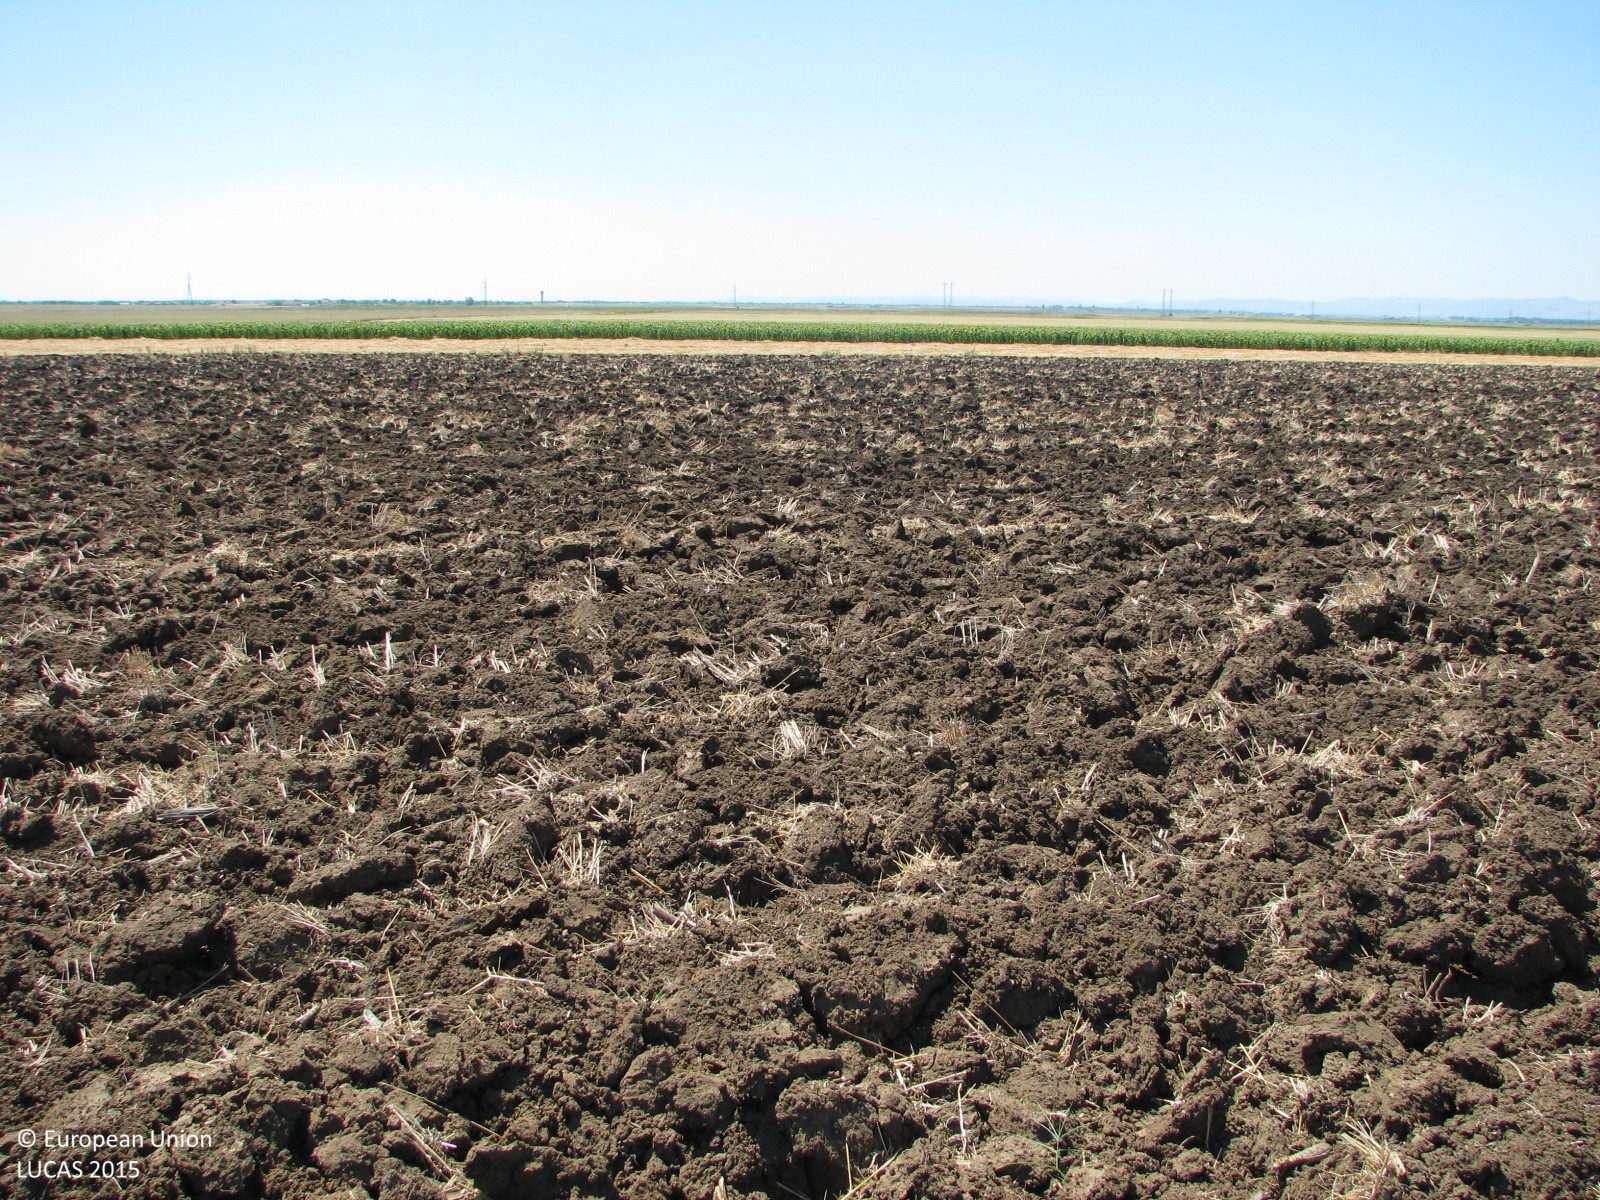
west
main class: Cropland
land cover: Common wheat
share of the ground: < 10 %
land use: Agriculture (excluding fallow land and kitchen gardens)
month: July
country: BG
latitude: 42.3550
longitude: 25.9455
